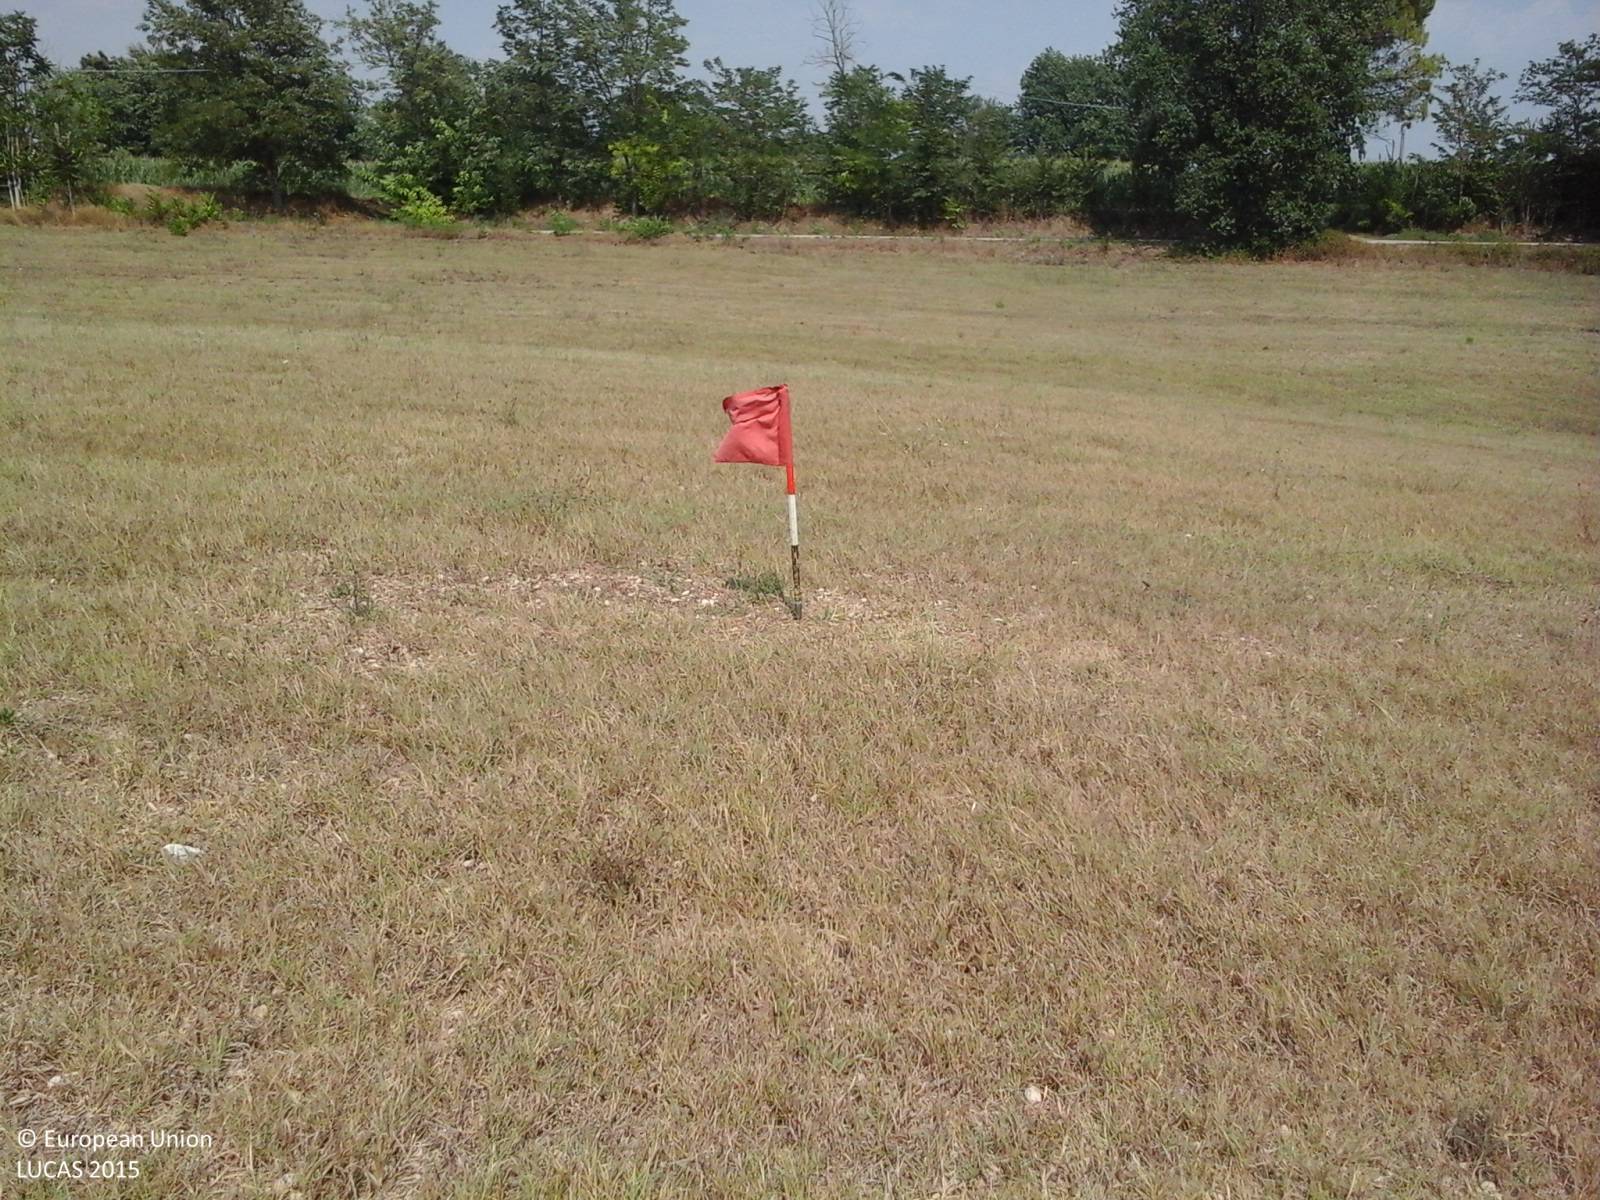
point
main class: Cropland
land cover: Temporary grasslands
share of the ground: > 75 %
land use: Agriculture (excluding fallow land and kitchen gardens)
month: August
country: IT
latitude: 41.4277
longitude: 13.7311
